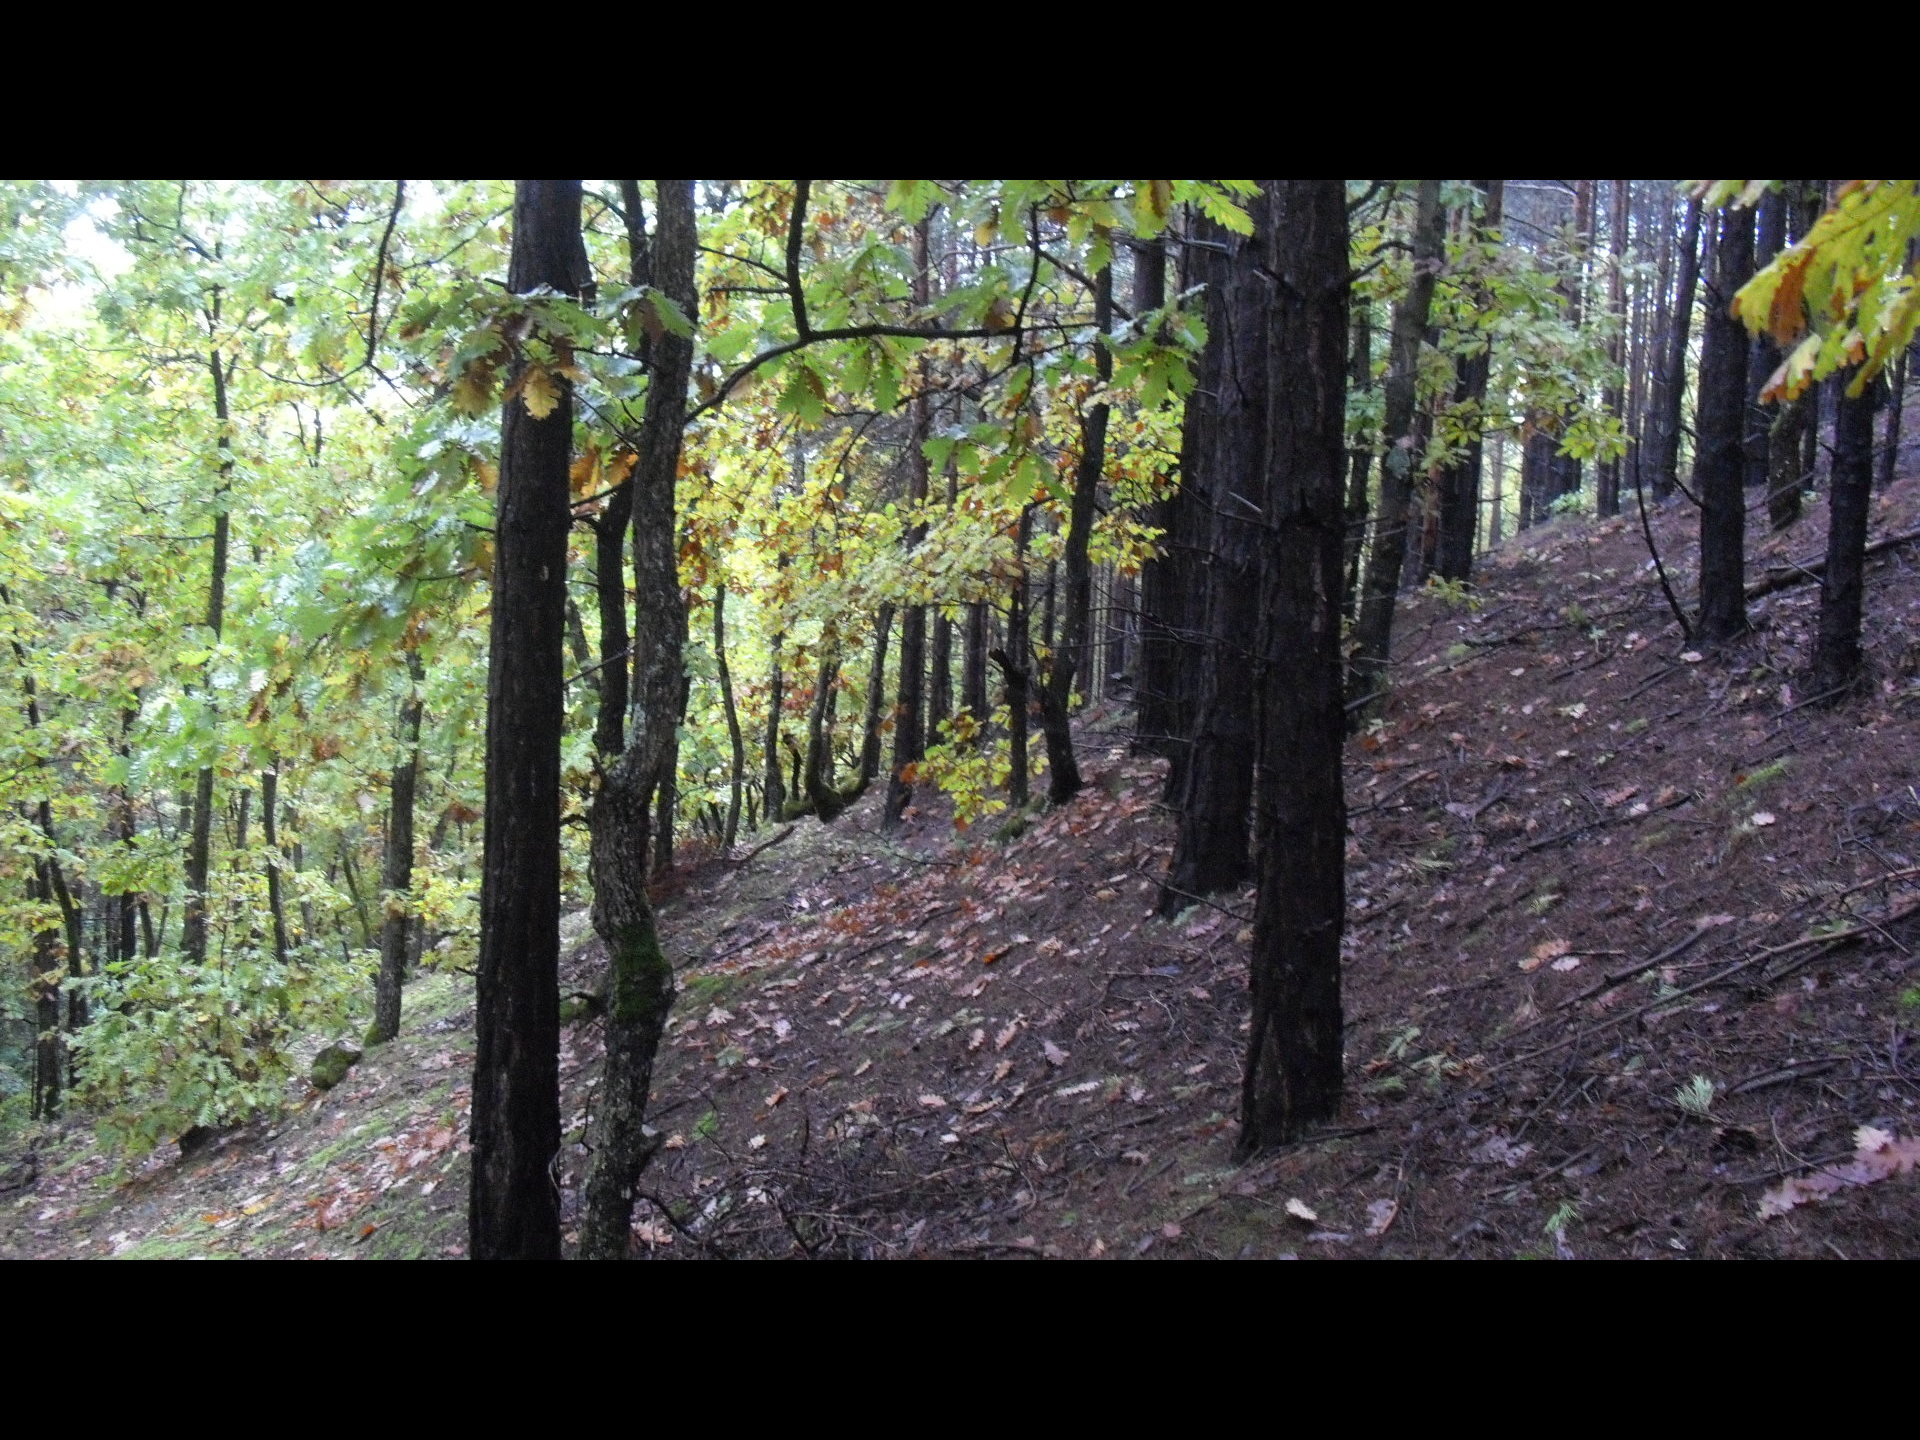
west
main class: Woodland
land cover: Broadleaved woodland
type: mesophytic deciduous forest
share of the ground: > 75 %
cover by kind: broadleaved forest trees 80 %, unconsolidated bare surface 20 %
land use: Forestry
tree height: > 5 m
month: October
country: BG
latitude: 43.6767
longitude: 22.5478
